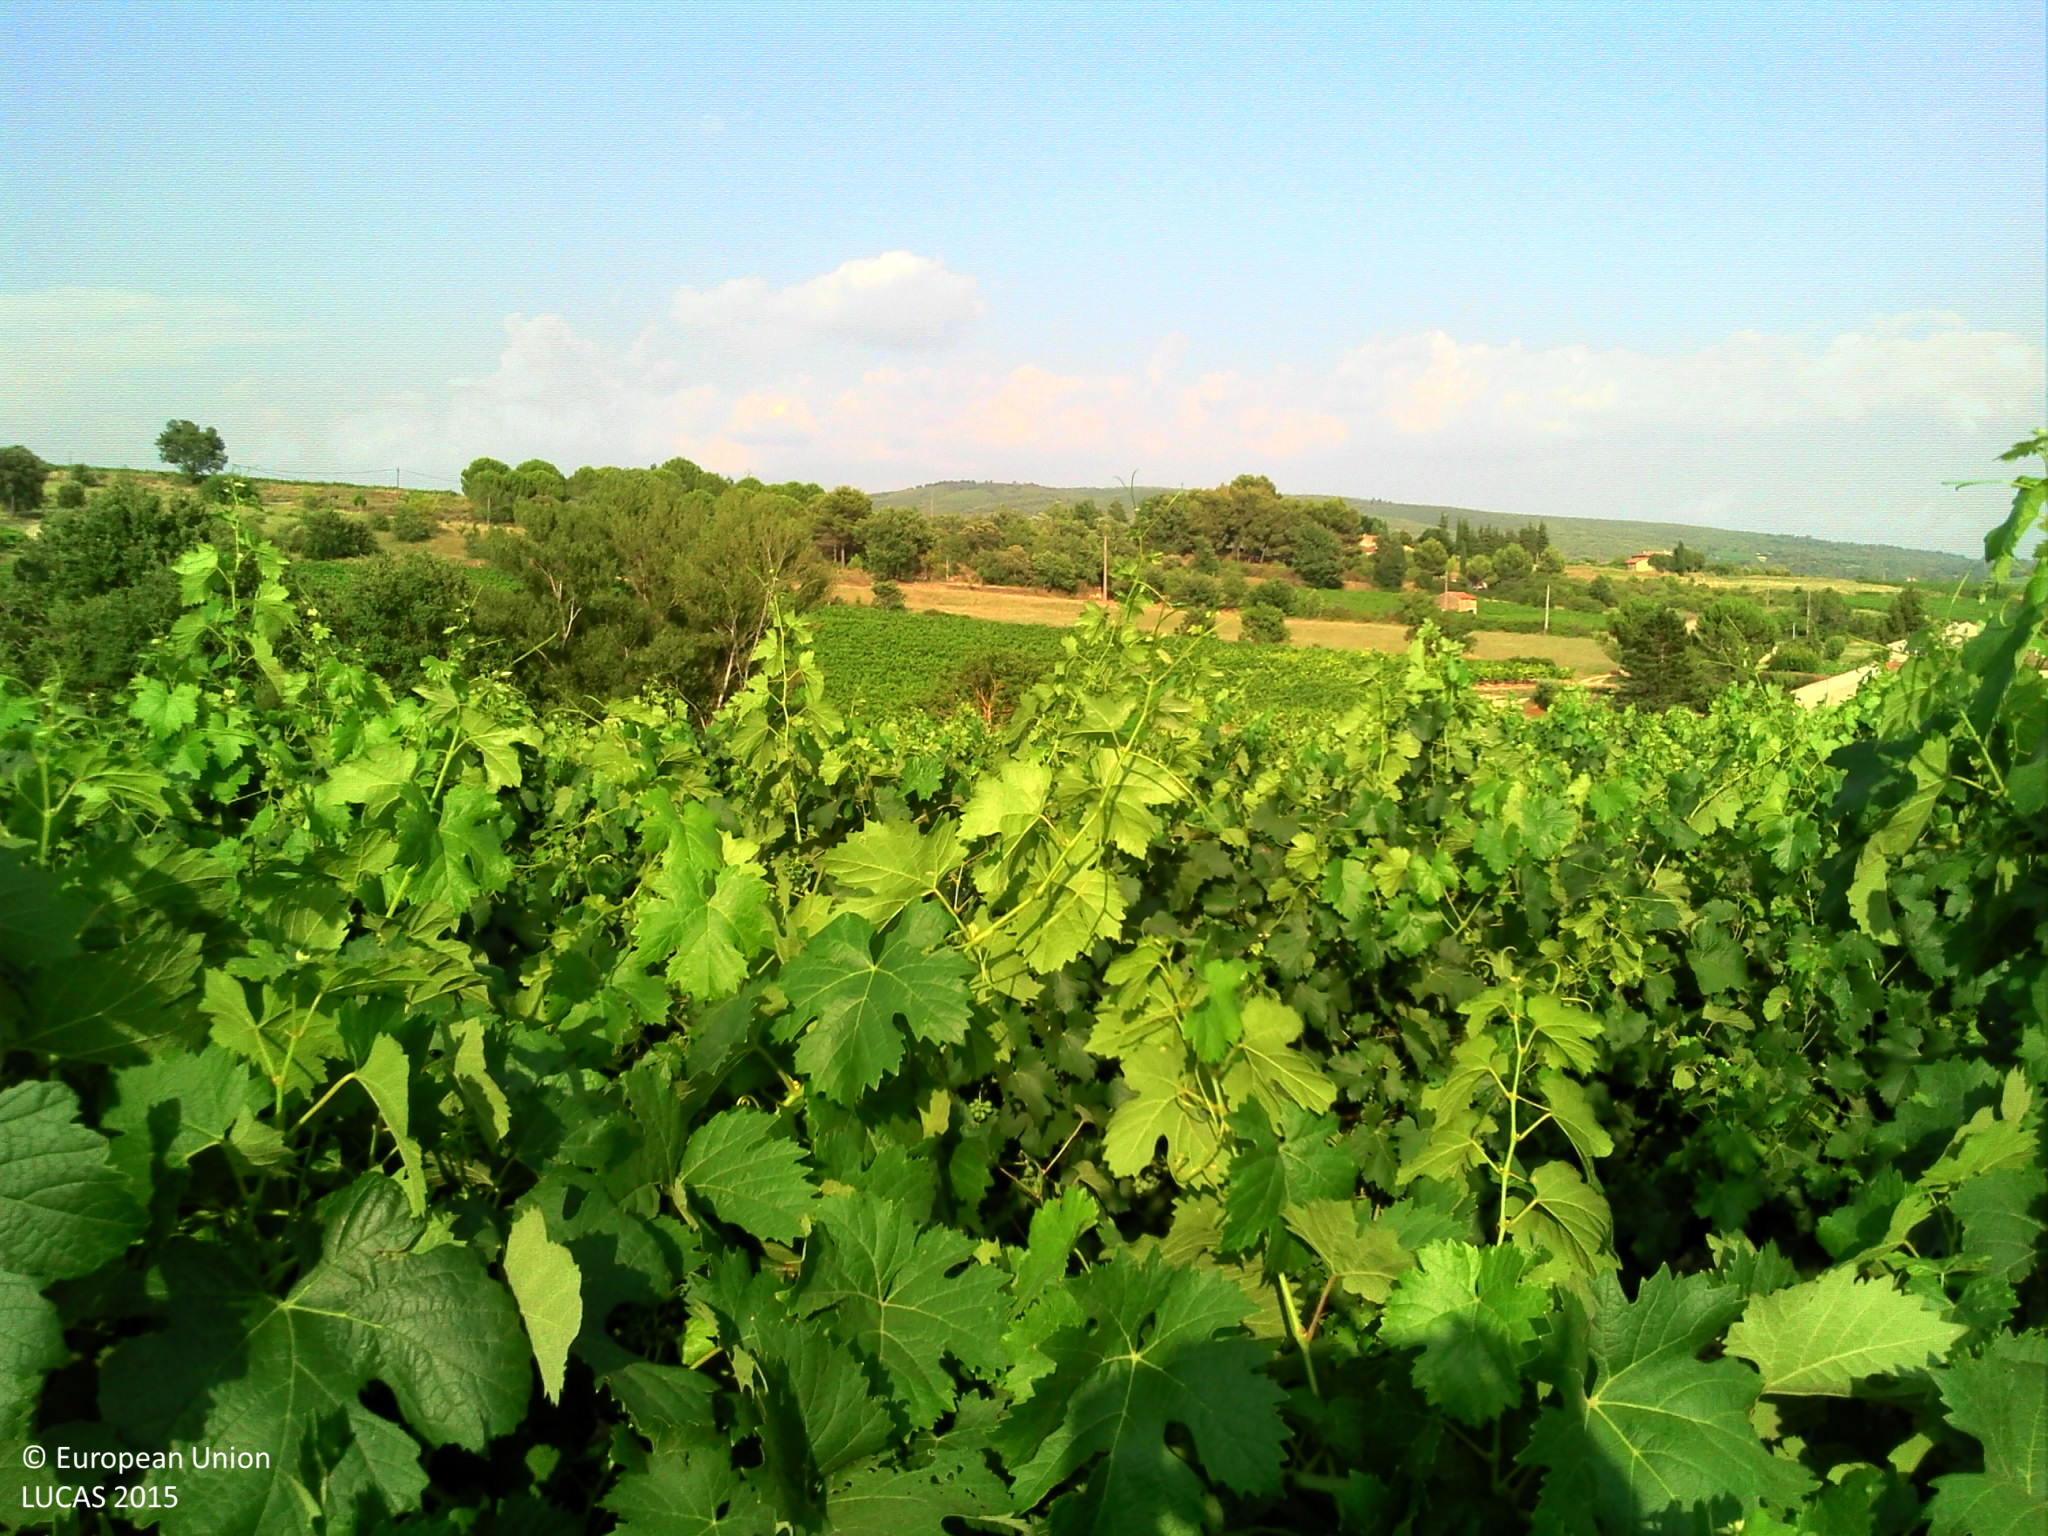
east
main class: Cropland
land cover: Vineyards
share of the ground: 25 - 50 %
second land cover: Other bare soil
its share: > 75 %
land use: Agriculture (excluding fallow land and kitchen gardens)
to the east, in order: Vineyards; Other bare soil; Tracks; Grass margins; Ditches and canals; Vineyards; Grass margins; Vineyards; Spontaneously vegetated surfaces; Rivers and streams; Broadleaved woodland; Grassland without tree/shrub cover; Managed hedges; Vineyards; Tracks; Lines of trees; Spontaneously vegetated surfaces
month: July
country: FR
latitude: 43.7493
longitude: 5.5506
